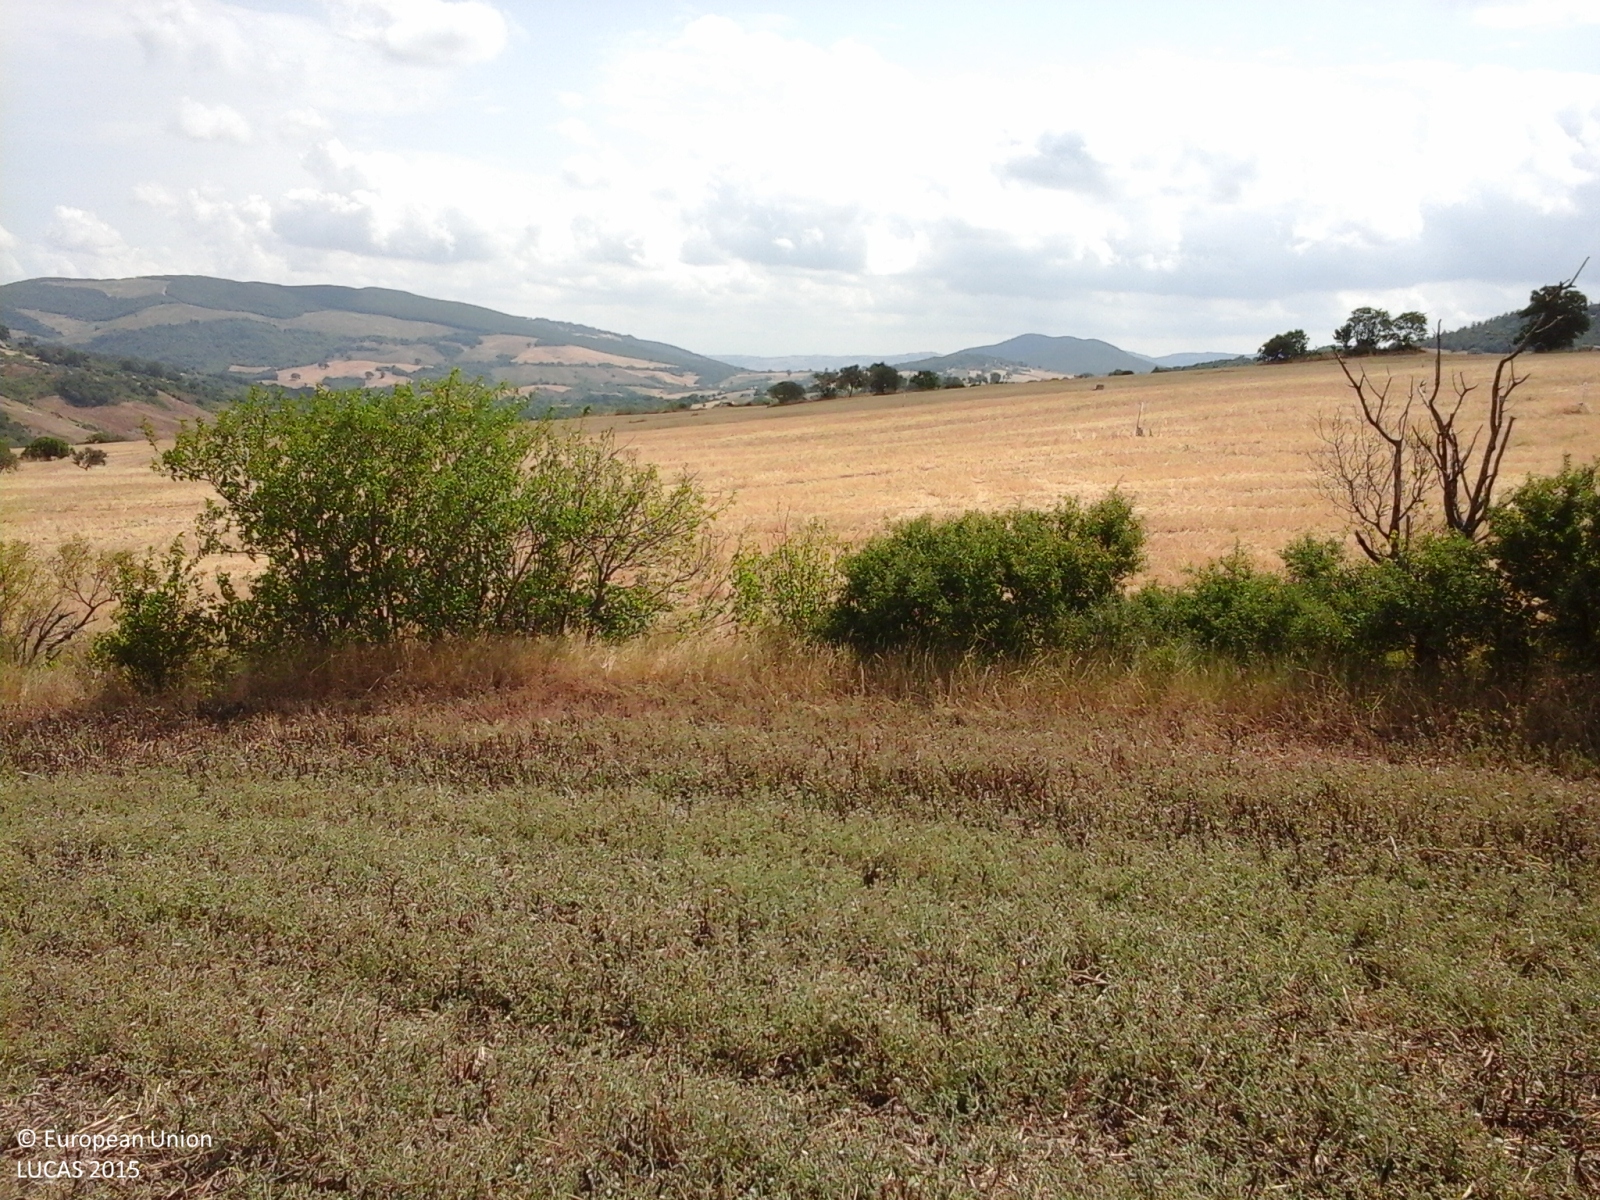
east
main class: Cropland
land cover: Dry pulses
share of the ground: > 75 %
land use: Agriculture (excluding fallow land and kitchen gardens)
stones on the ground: < 10 %
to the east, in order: Dry pulses; Abandoned hedges; Ditches and canals; Durum wheat; Olive groves; Durum wheat; Grass margins; Paved roads, cycling and walking lanes
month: July
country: IT
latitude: 41.8035
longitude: 14.6906
